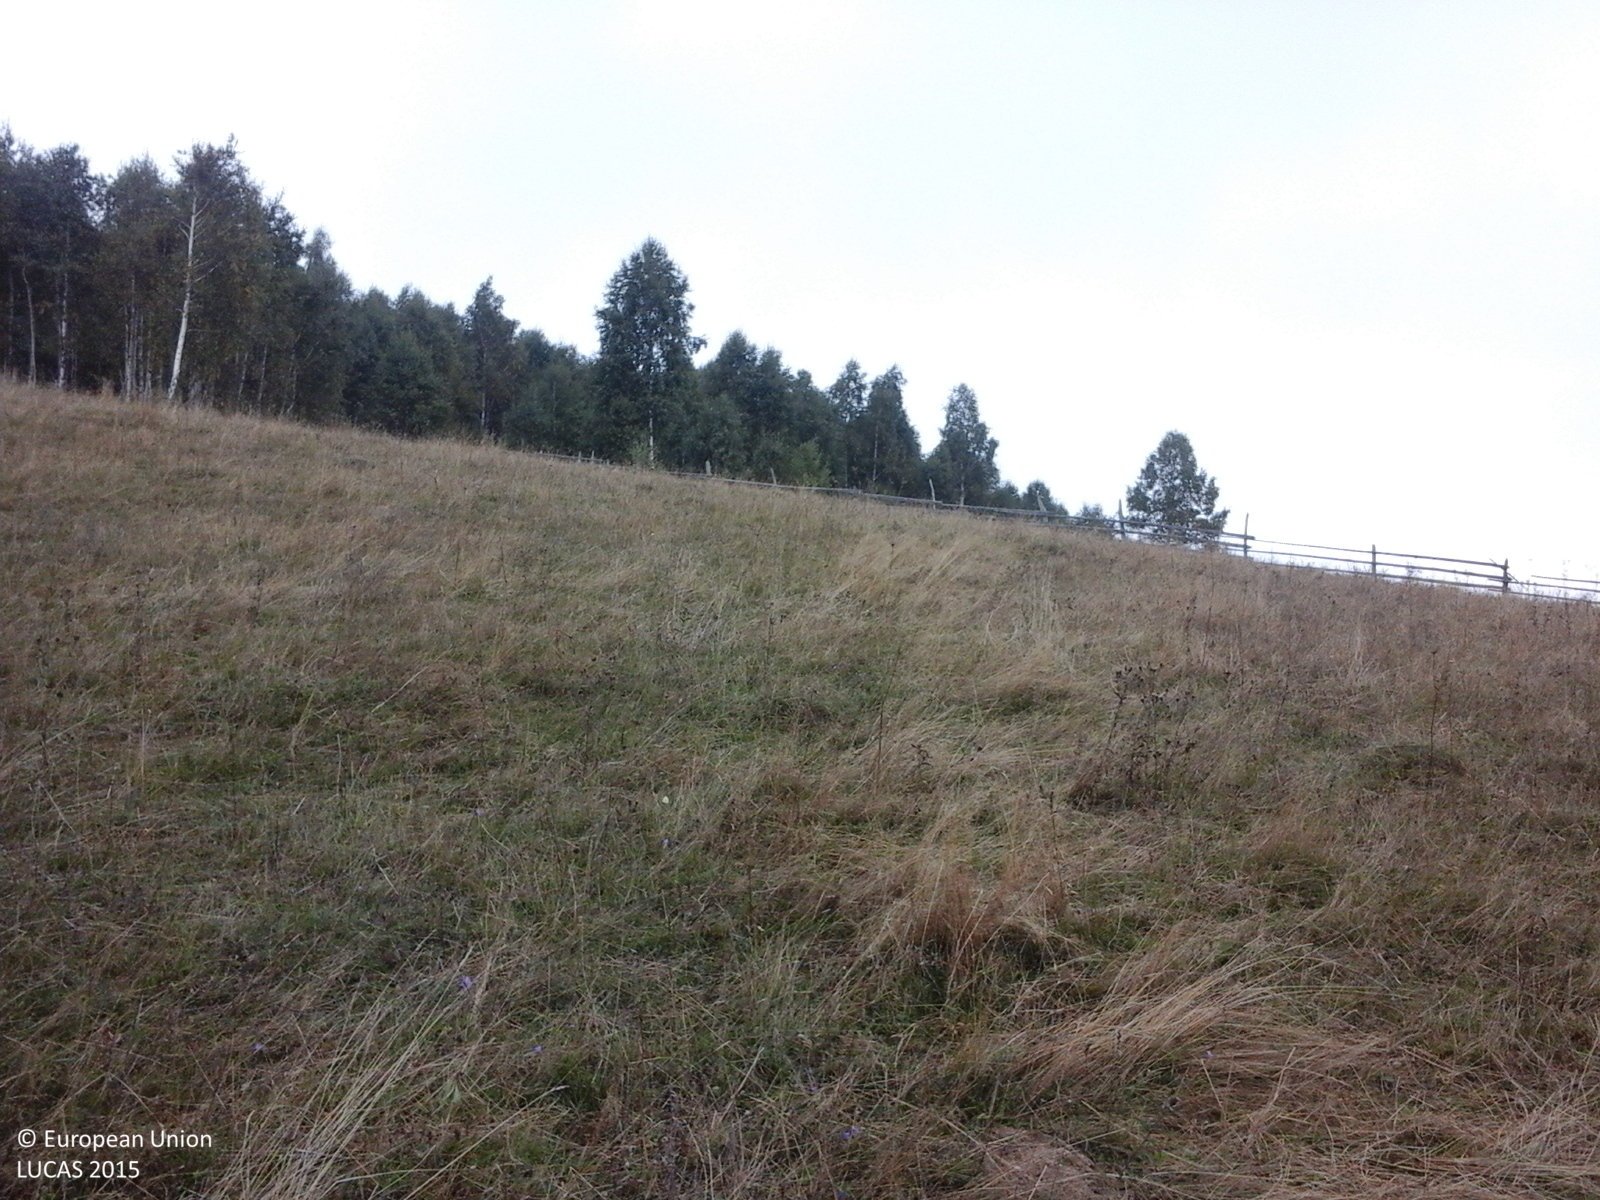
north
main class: Grassland
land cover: Grassland without tree/shrub cover
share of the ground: > 75 %
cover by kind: herbaceous plants 100 %
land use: Agriculture (excluding fallow land and kitchen gardens)
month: October
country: RO
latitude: 45.7560
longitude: 23.7067
